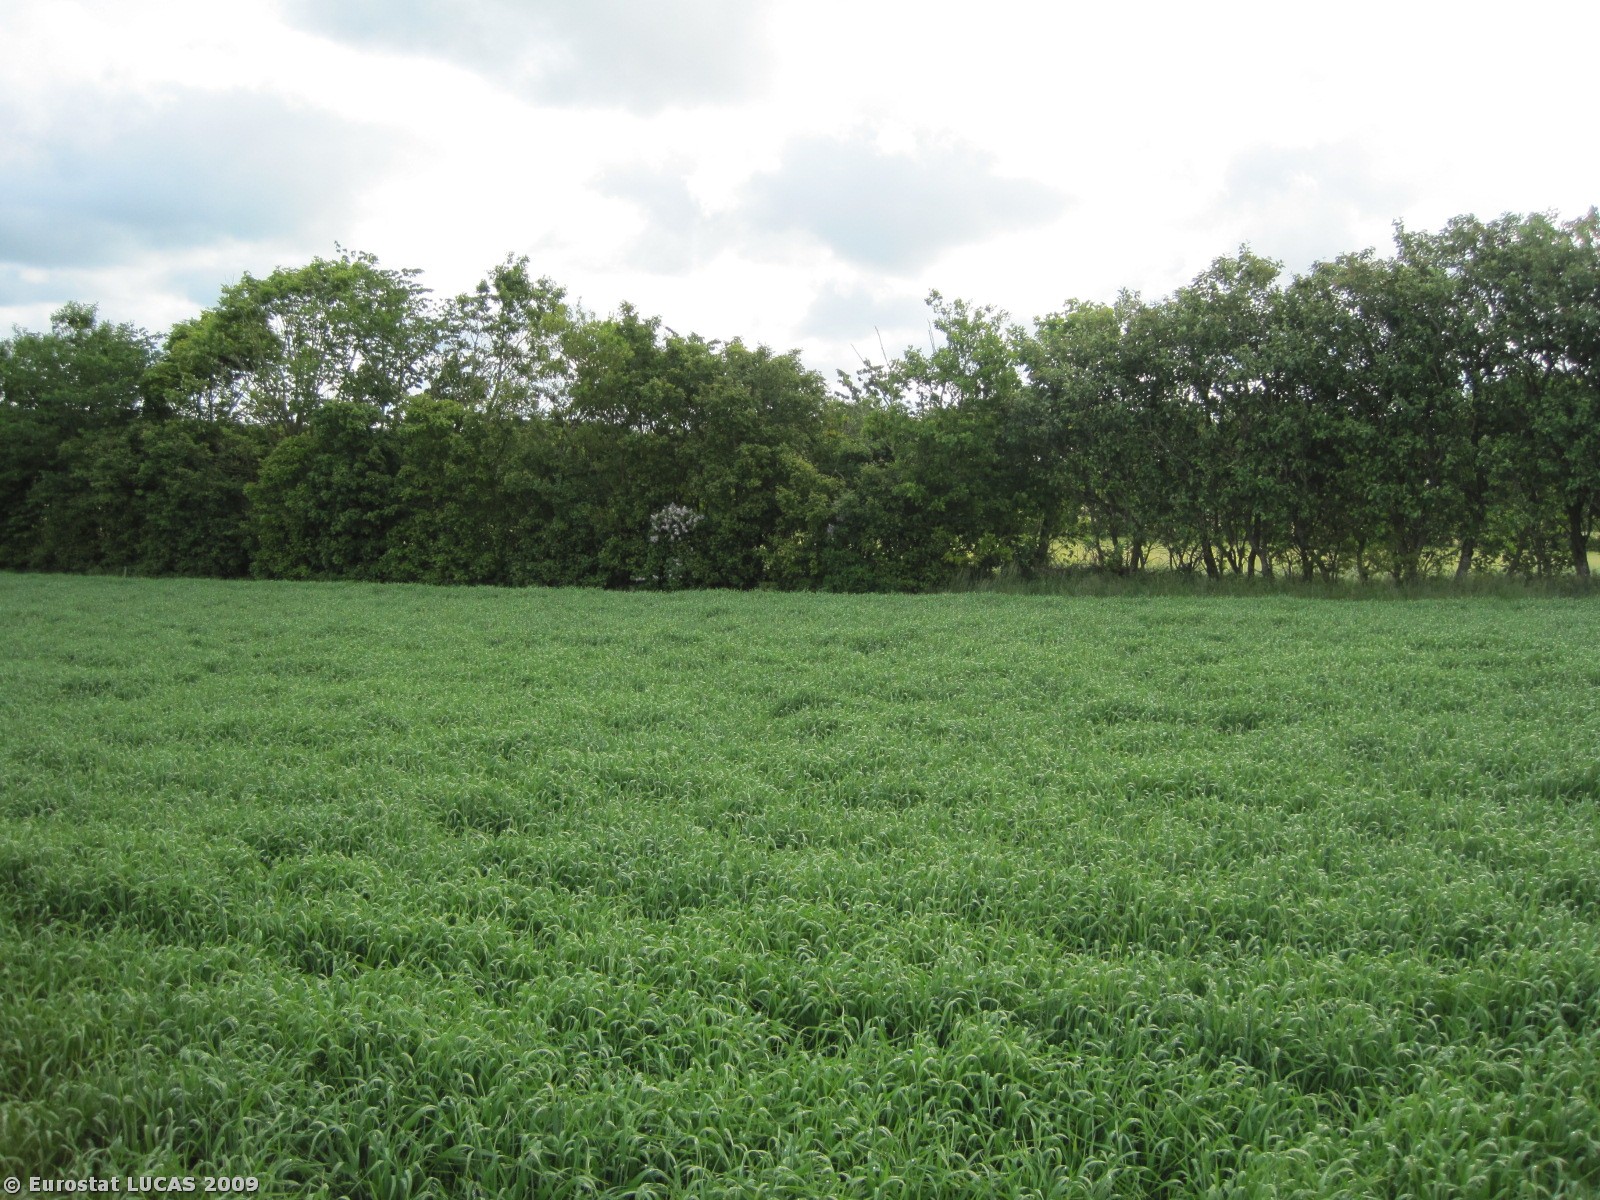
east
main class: Cropland
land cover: Barley
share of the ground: > 75 %
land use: Agriculture (excluding fallow land and kitchen gardens)
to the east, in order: Barley; Fences; Grass margins; Broadleaved woodland; Grass margins; Barley; Grass margins; Broadleaved woodland; Grass margins; Barley
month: June
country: DK
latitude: 57.2844
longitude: 10.0166
